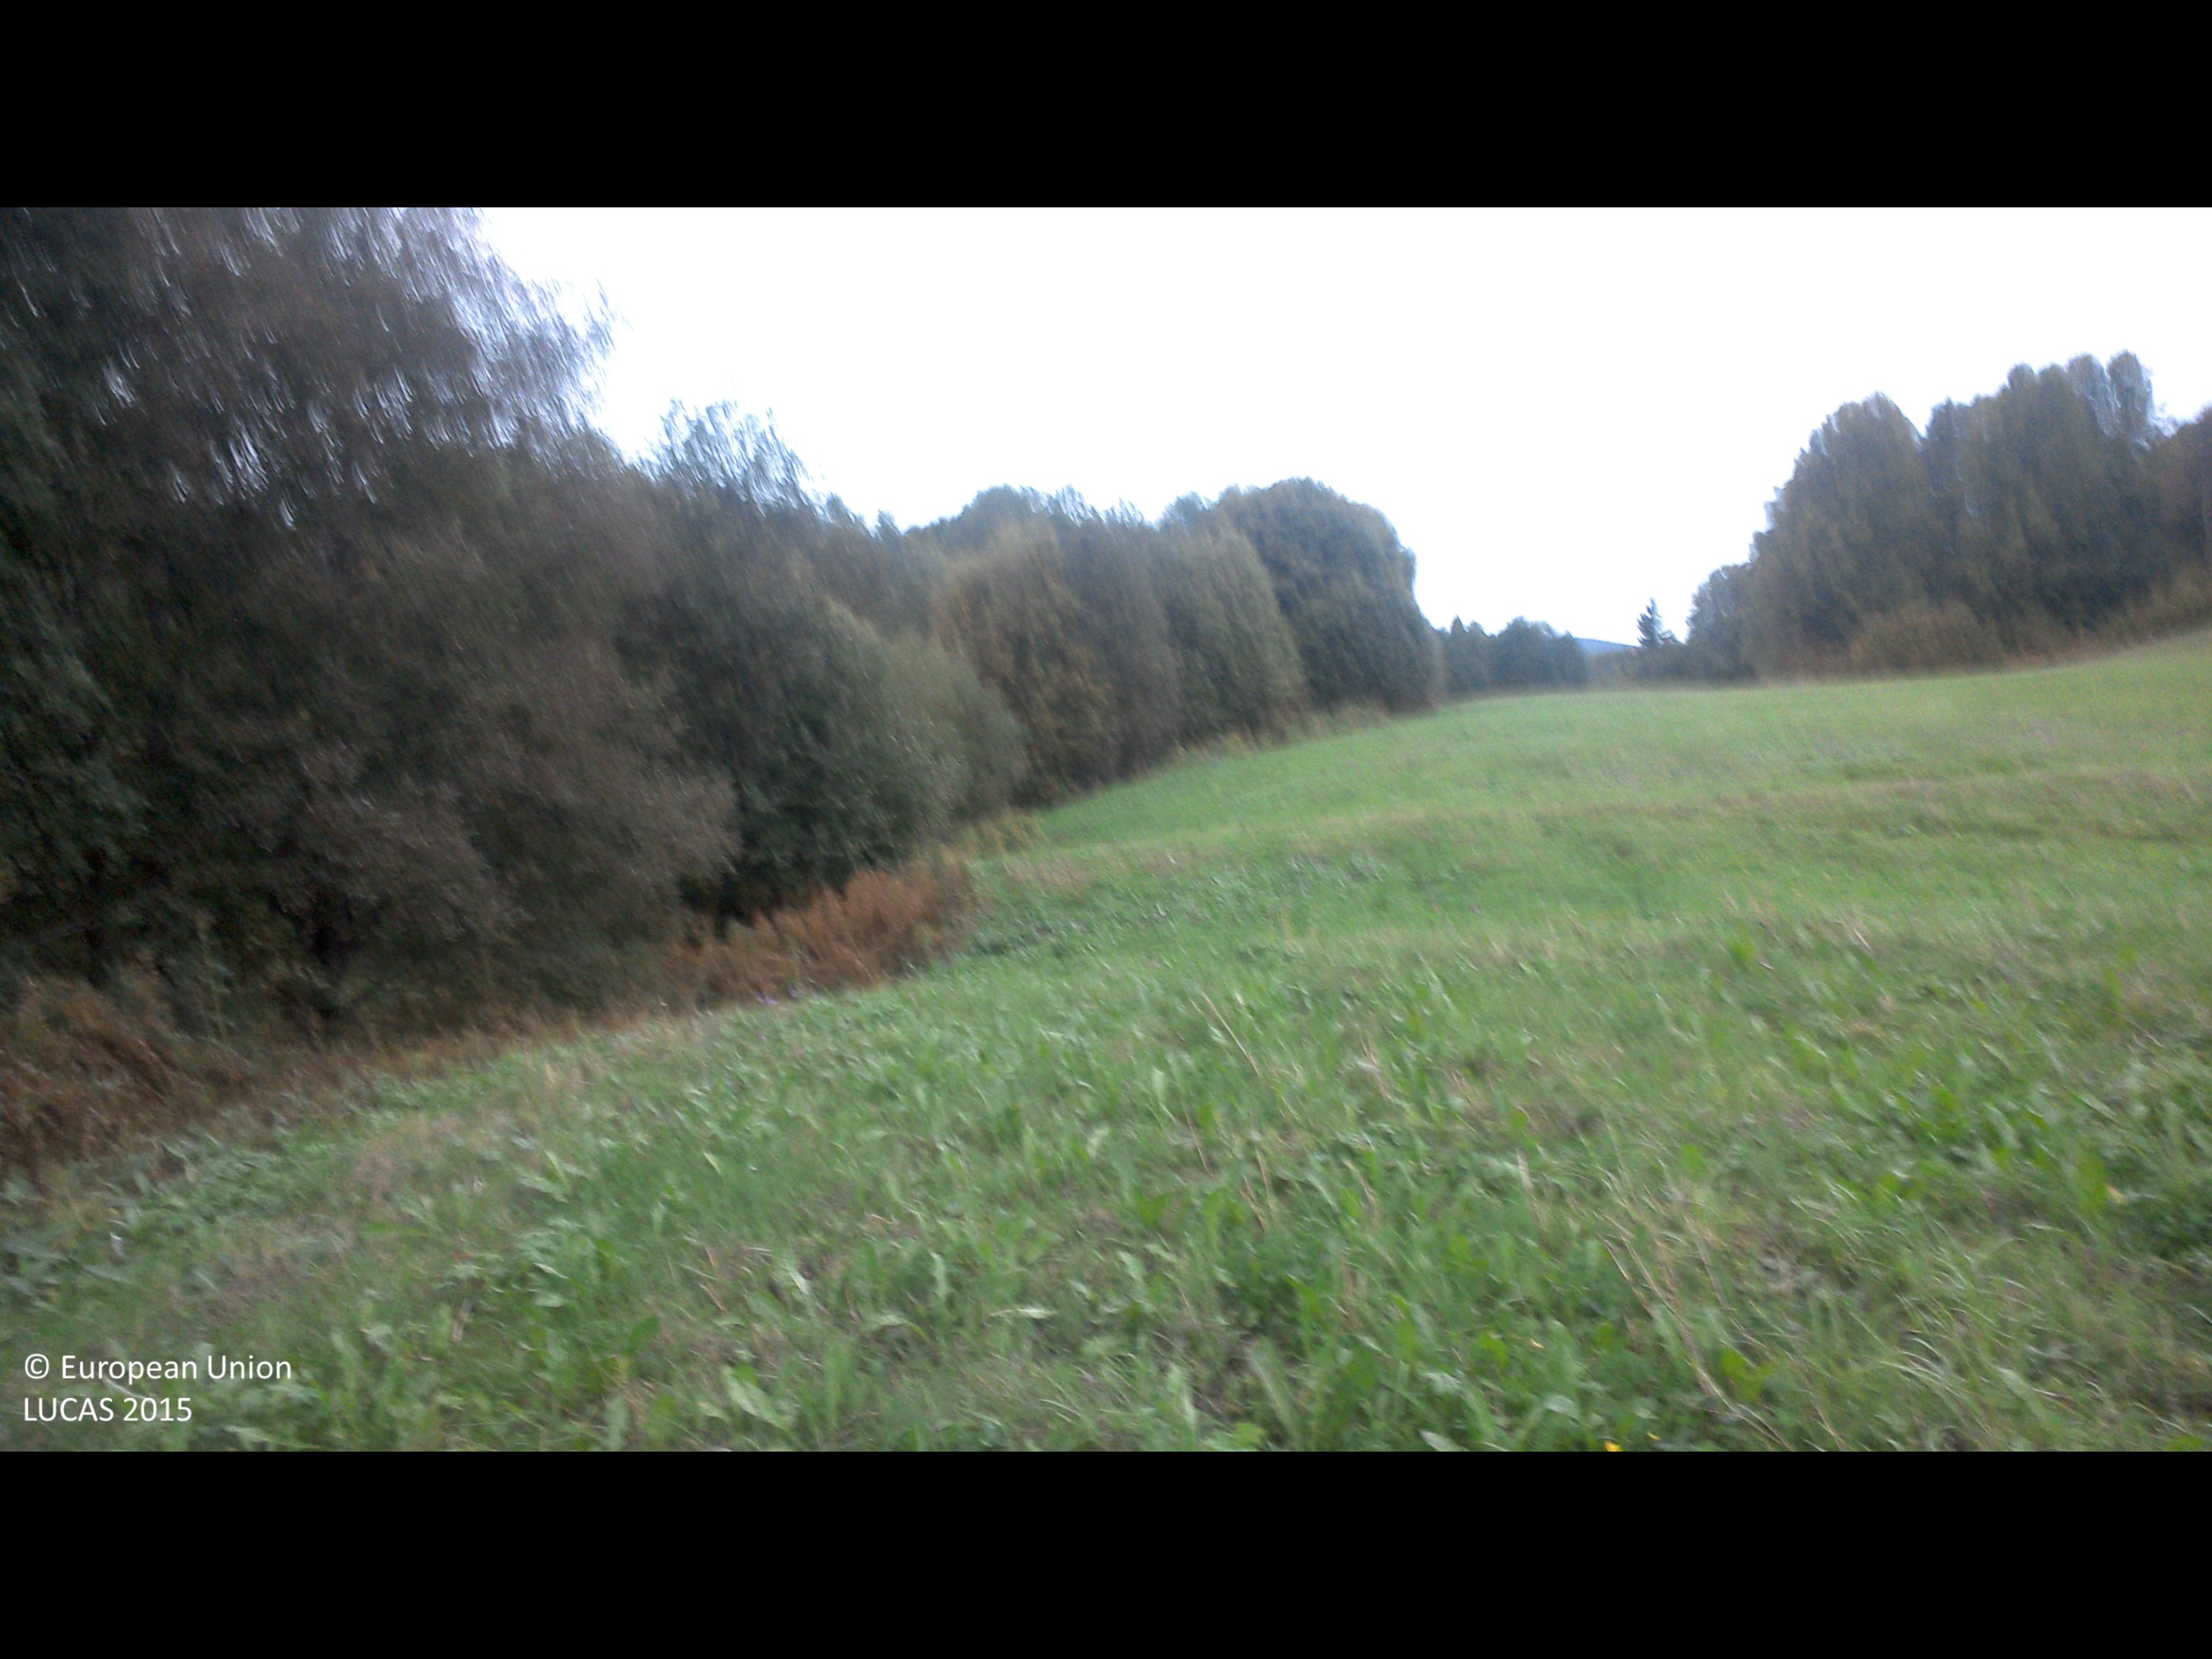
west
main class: Grassland
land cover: Grassland without tree/shrub cover
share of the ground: > 75 %
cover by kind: herbaceous plants 100 %
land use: Agriculture (excluding fallow land and kitchen gardens)
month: September
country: SE
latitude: 63.8574
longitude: 20.0905
